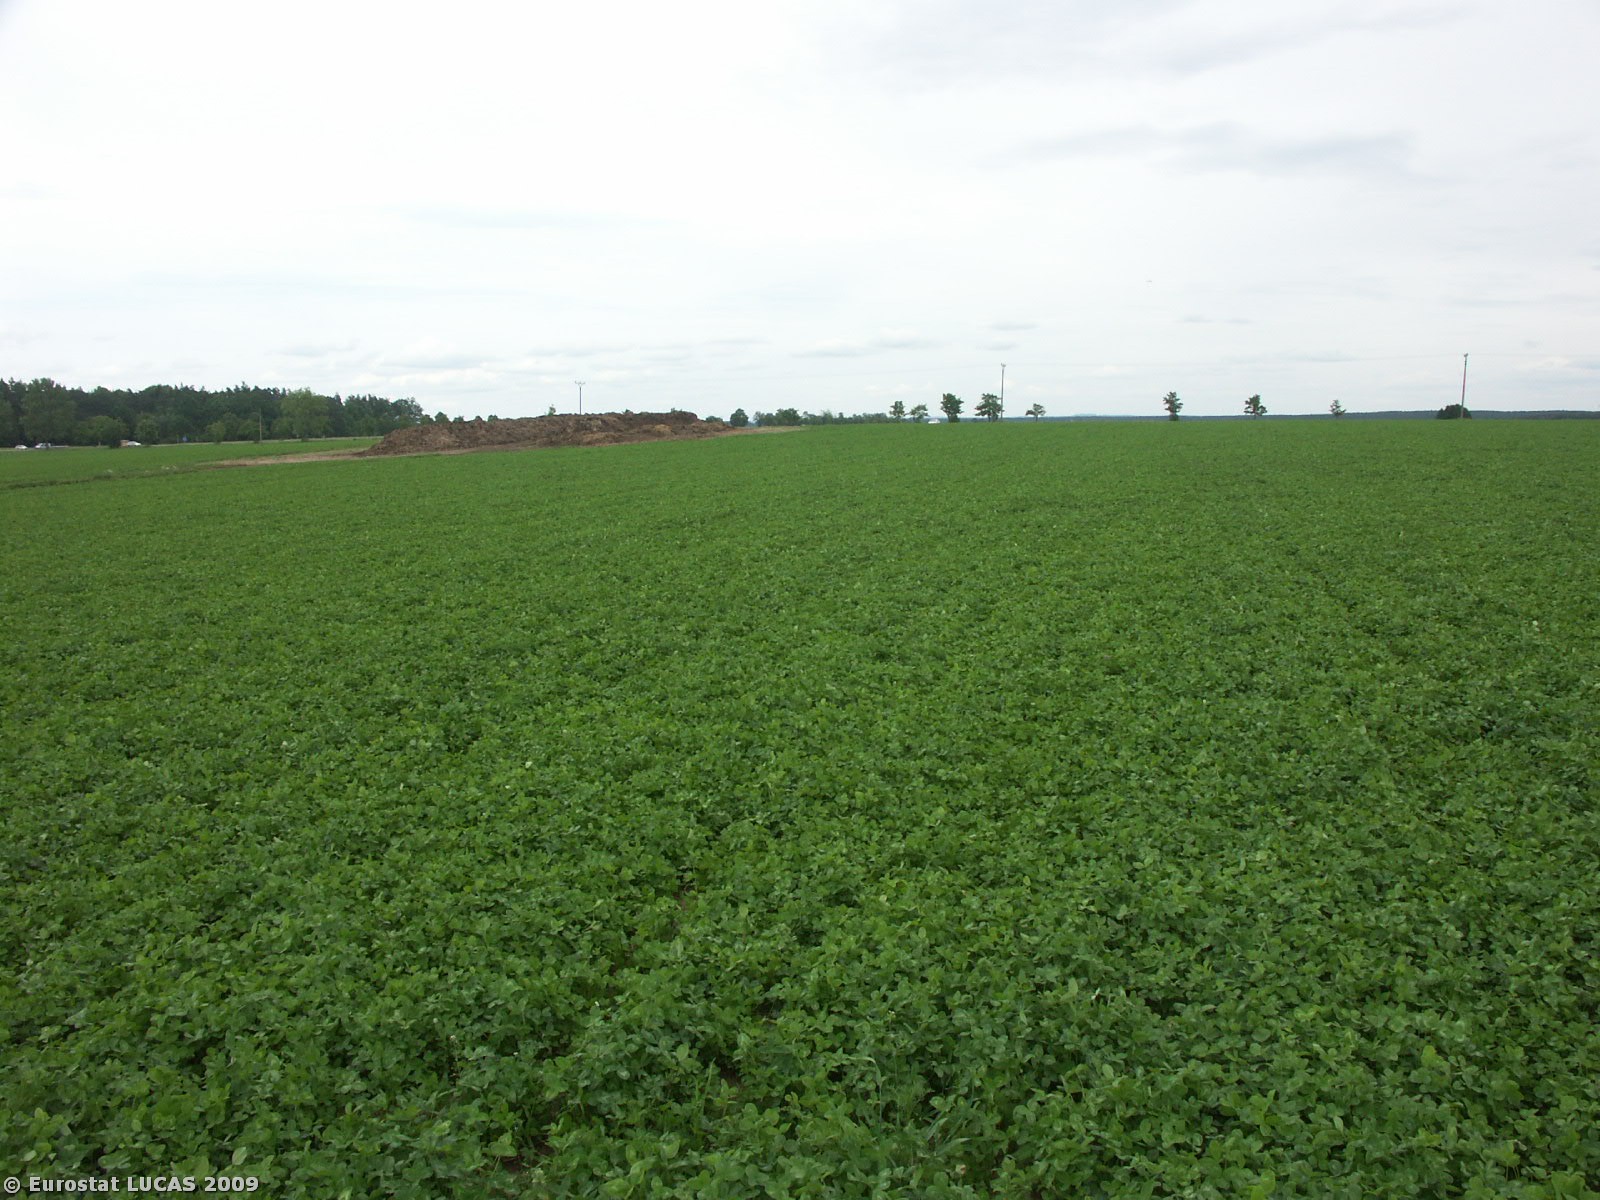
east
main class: Cropland
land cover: Clovers
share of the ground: > 75 %
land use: Agriculture (excluding fallow land and kitchen gardens)
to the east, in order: Clovers; Electric lines; Clovers; Tracks; Spontaneously vegetated surfaces
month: June
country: CZ
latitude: 48.9721
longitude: 14.6599
